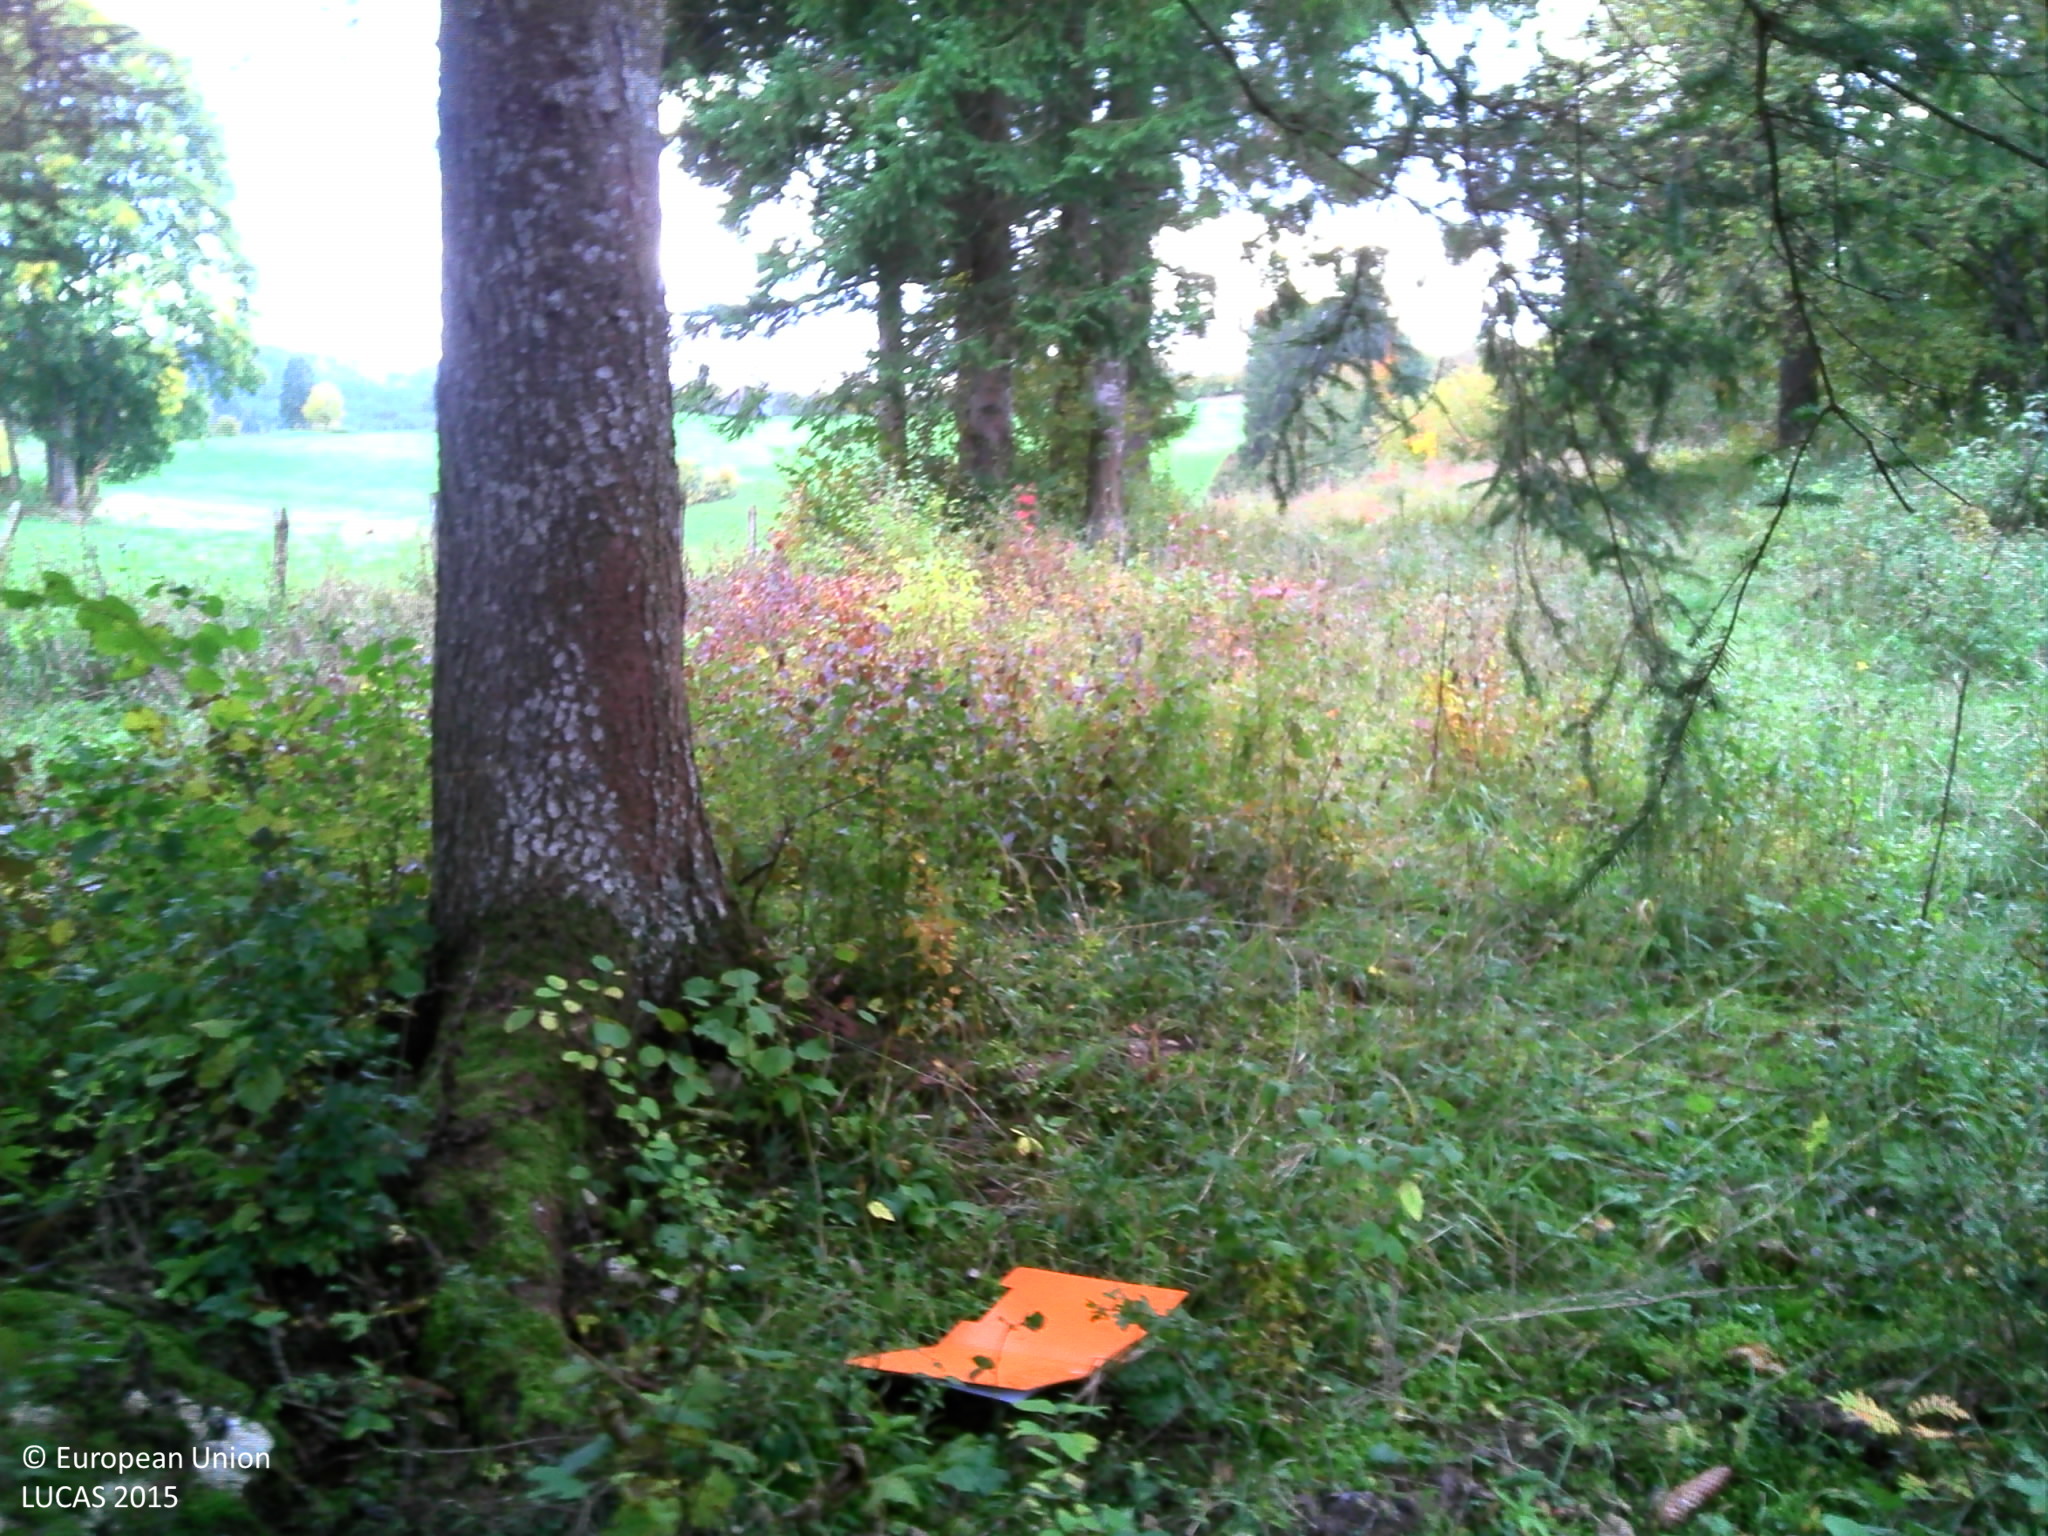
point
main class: Woodland
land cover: Spruce dominated coniferous woodland
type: hemiboreal forest and nemoral coniferous forest and mixed broadleaved-coniferous forest
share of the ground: > 75 %
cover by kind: coniferous forest trees 100 %
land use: Forestry
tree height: > 5 m
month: October
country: FR
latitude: 46.7739
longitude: 6.2964
